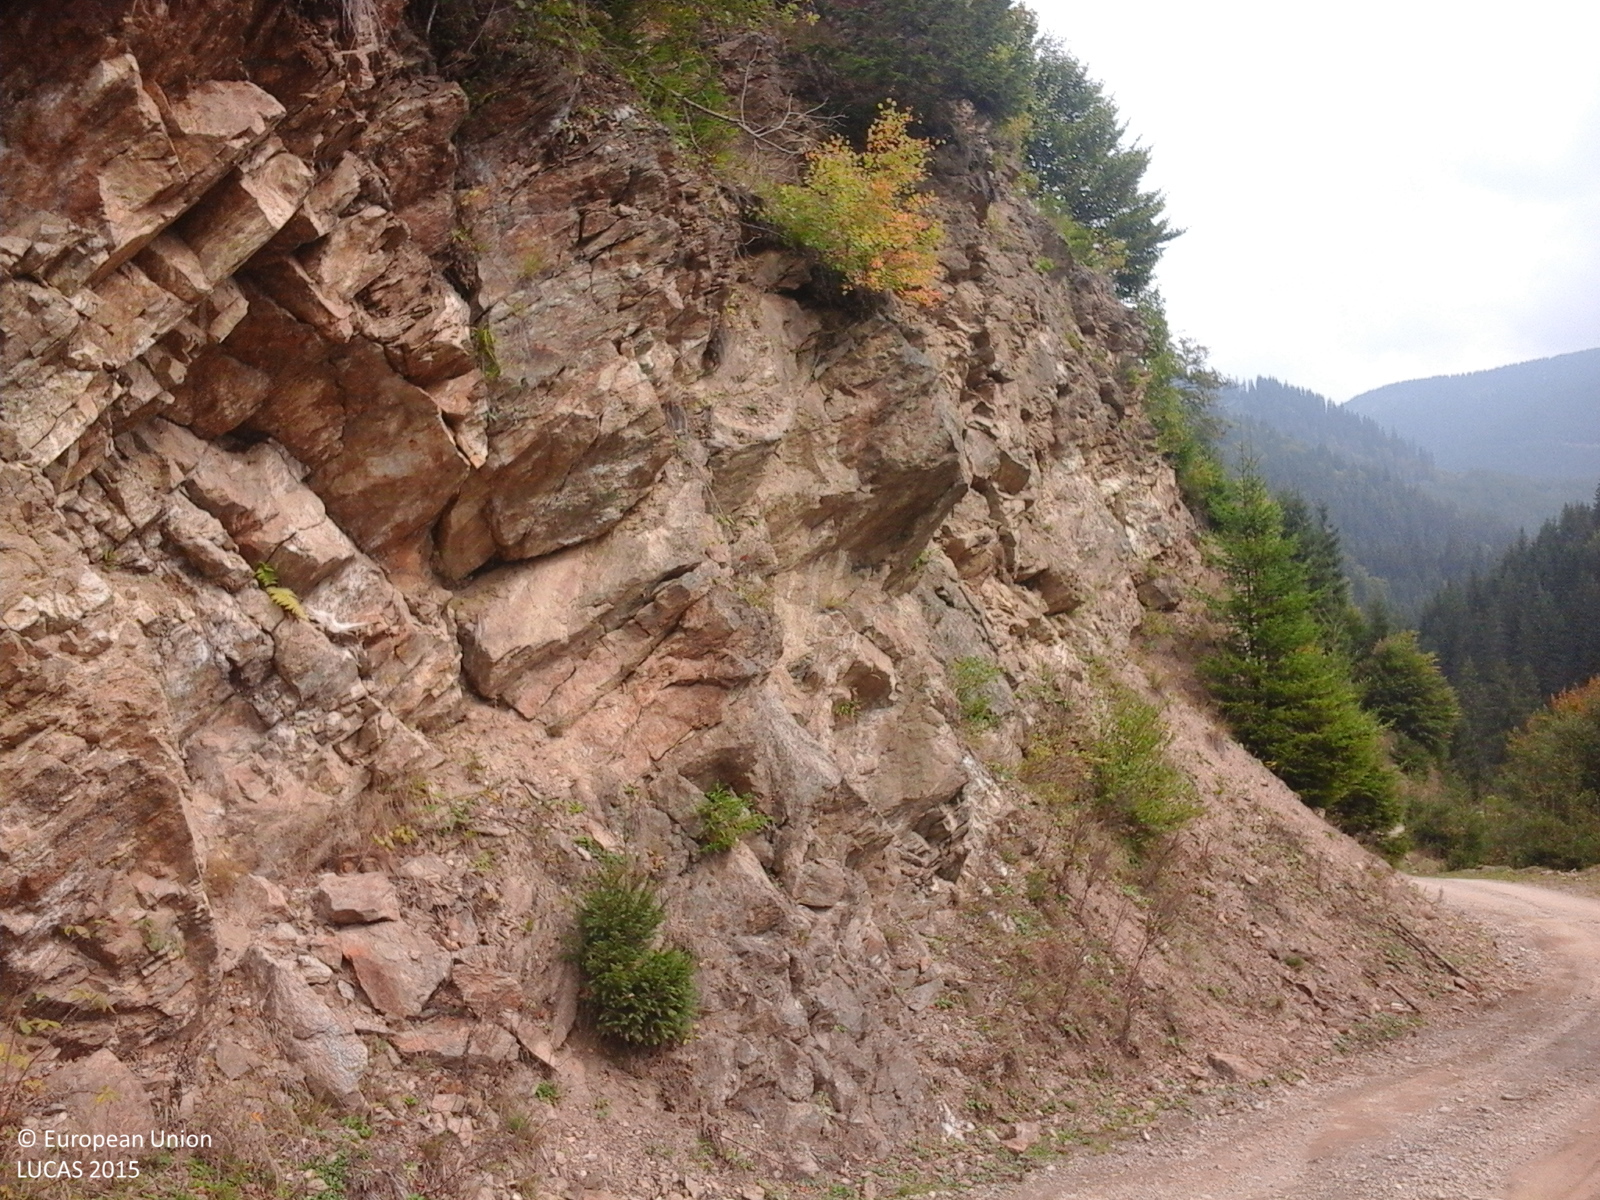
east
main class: Woodland
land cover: Spruce dominated mixed woodland
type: alpine coniferous forest
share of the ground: > 75 %
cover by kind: coniferous forest trees 65 %, broadleaved forest trees 35 %
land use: Forestry
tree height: > 5 m
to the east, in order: Spruce dominated mixed woodland
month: September
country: RO
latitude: 45.4123
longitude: 23.5417
